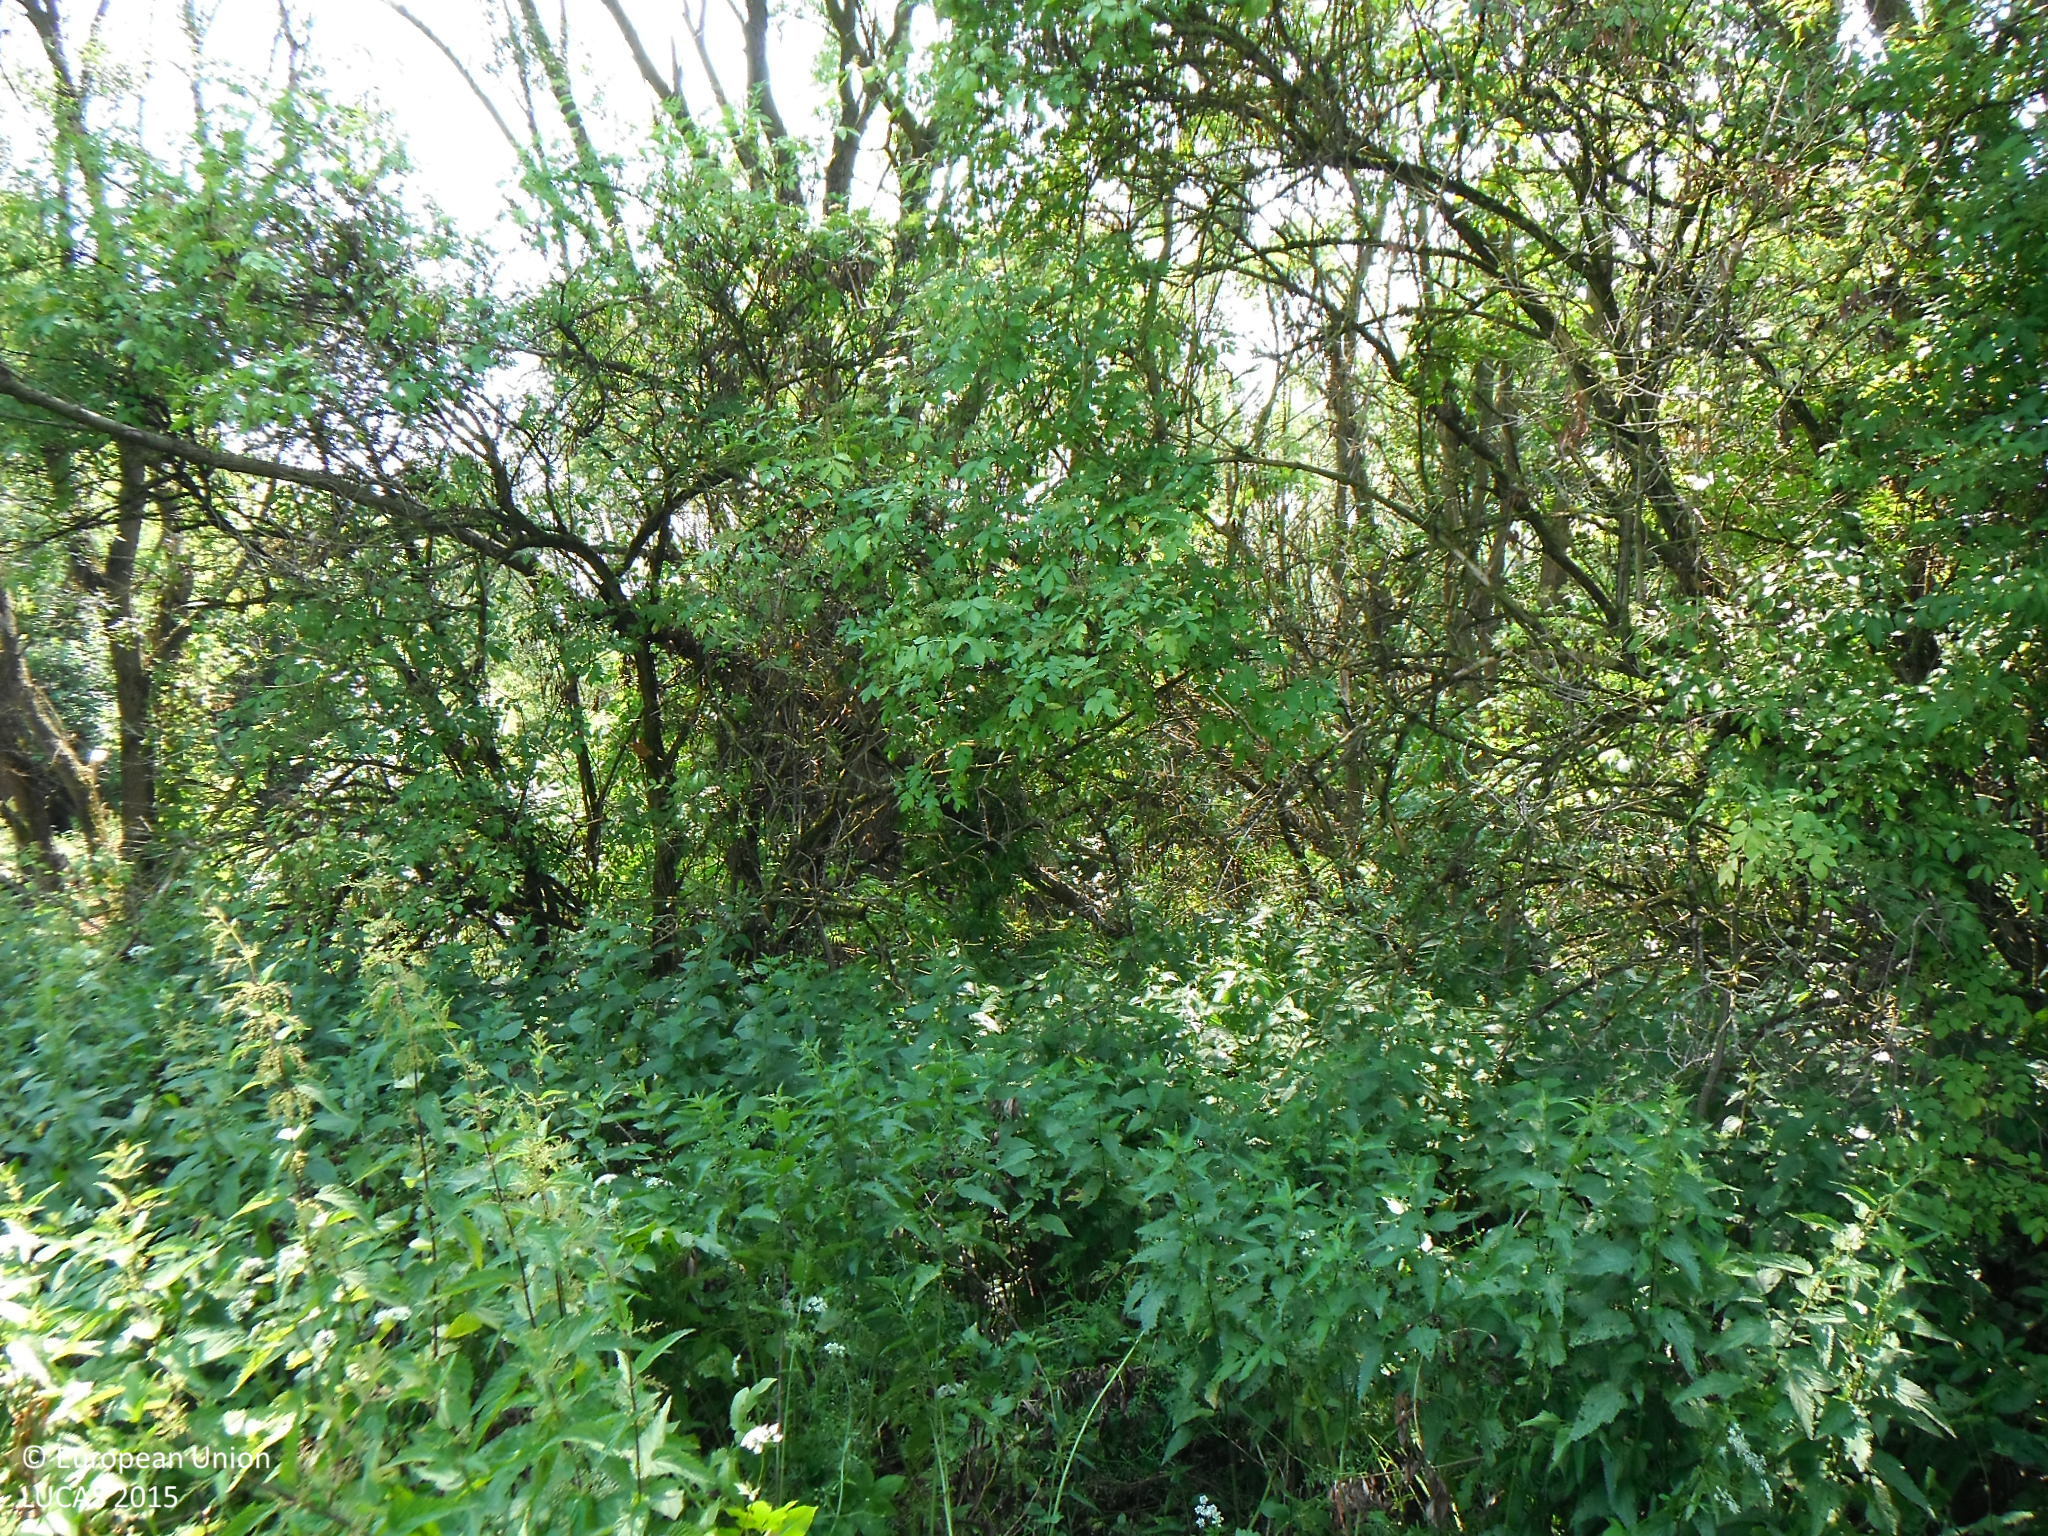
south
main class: Grassland
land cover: Spontaneously vegetated surfaces
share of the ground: > 75 %
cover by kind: herbaceous plants 95 %, shrubs 5 %
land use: Abandoned areas
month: July
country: SK
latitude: 49.4114
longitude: 21.3912
